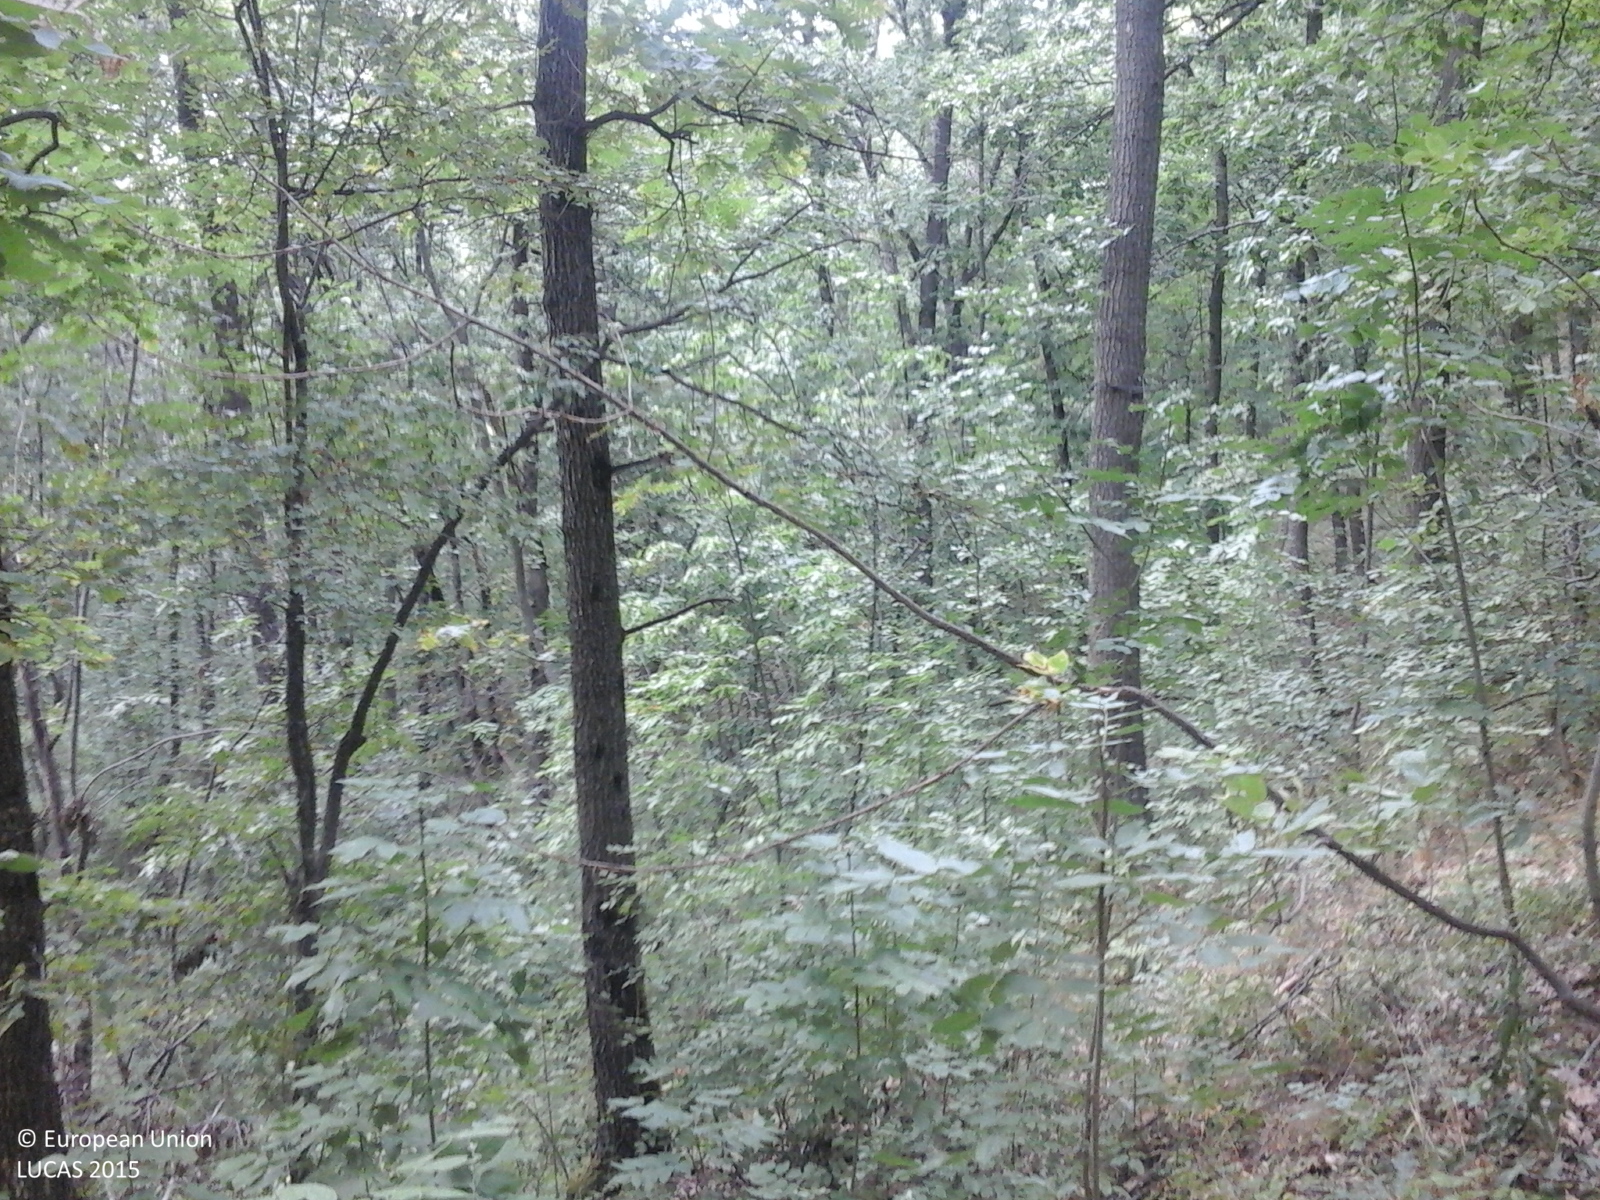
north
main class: Woodland
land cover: Broadleaved woodland
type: acidophilous oak and oak-birch forest
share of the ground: > 75 %
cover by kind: broadleaved forest trees 100 %
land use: Forestry
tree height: > 5 m
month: August
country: RO
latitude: 44.5434
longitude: 23.2016
